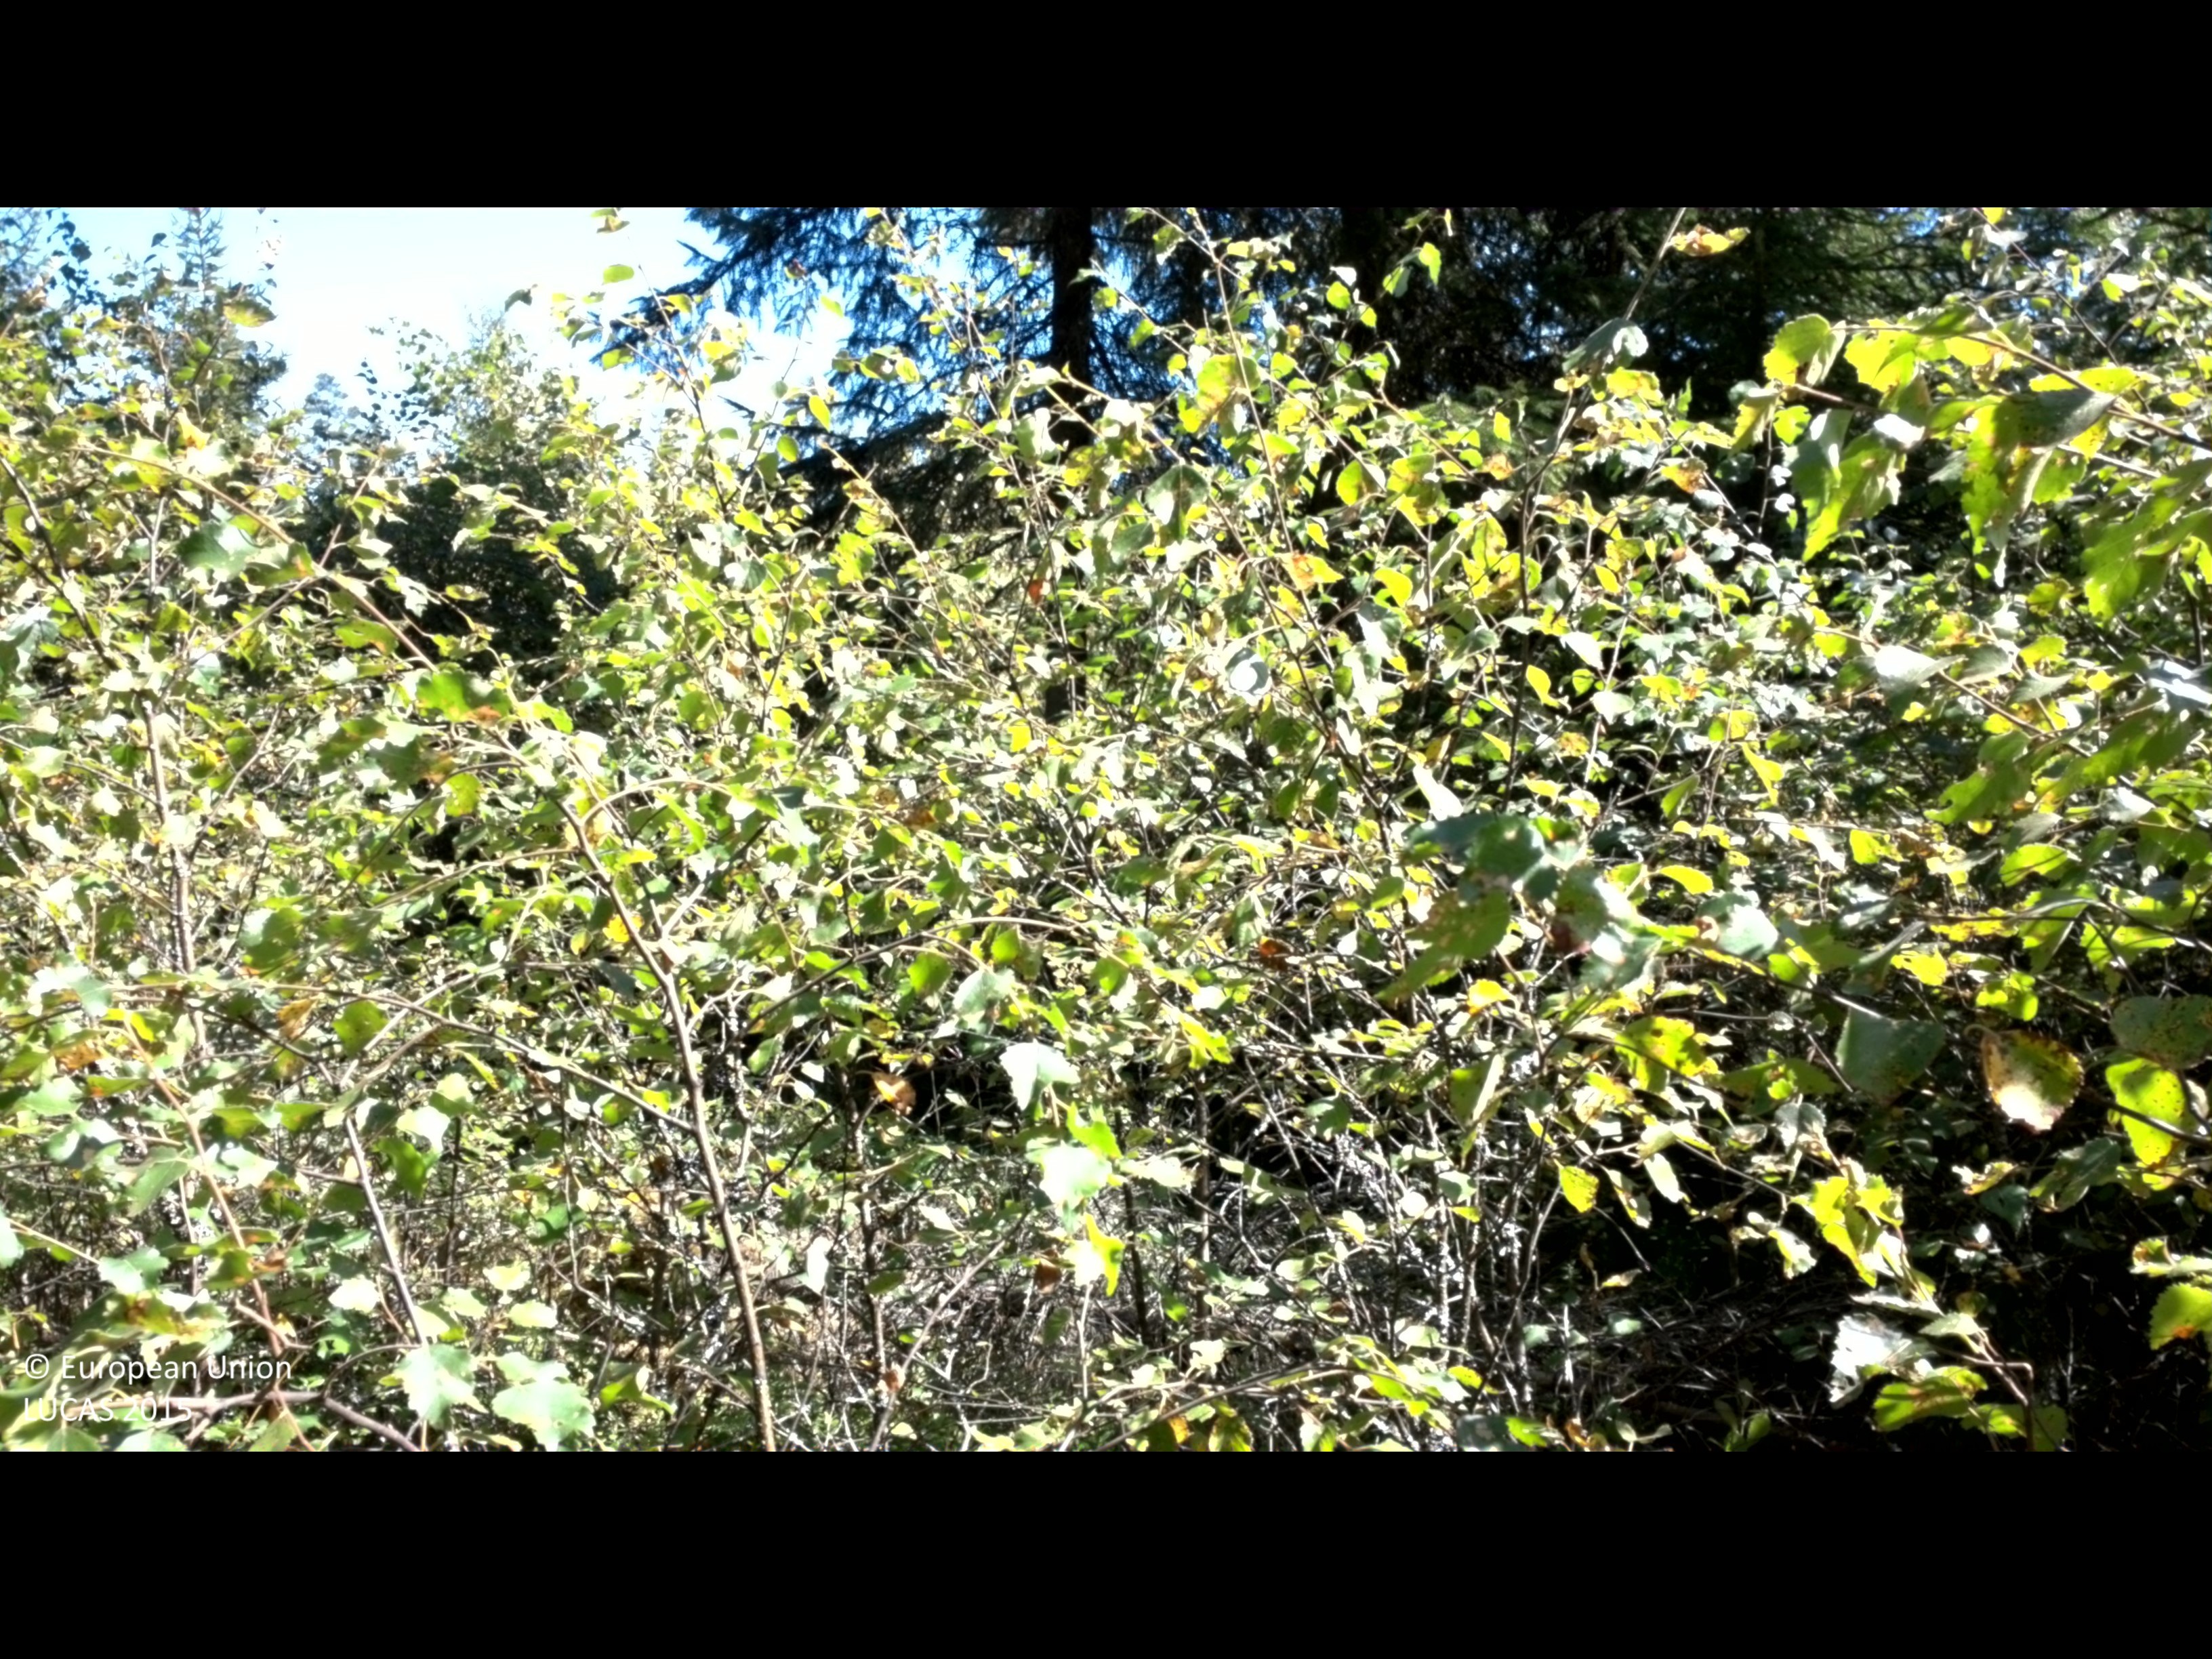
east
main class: Woodland
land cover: Spruce dominated mixed woodland
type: boreal forest
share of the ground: > 75 %
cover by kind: broadleaved forest trees 55 %, coniferous forest trees 30 %, shrubs 10 %, herbaceous plants 5 %
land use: Forestry
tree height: > 5 m
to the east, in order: Spruce dominated mixed woodland; Broadleaved woodland
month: August
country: SE
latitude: 56.7281
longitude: 14.2953
